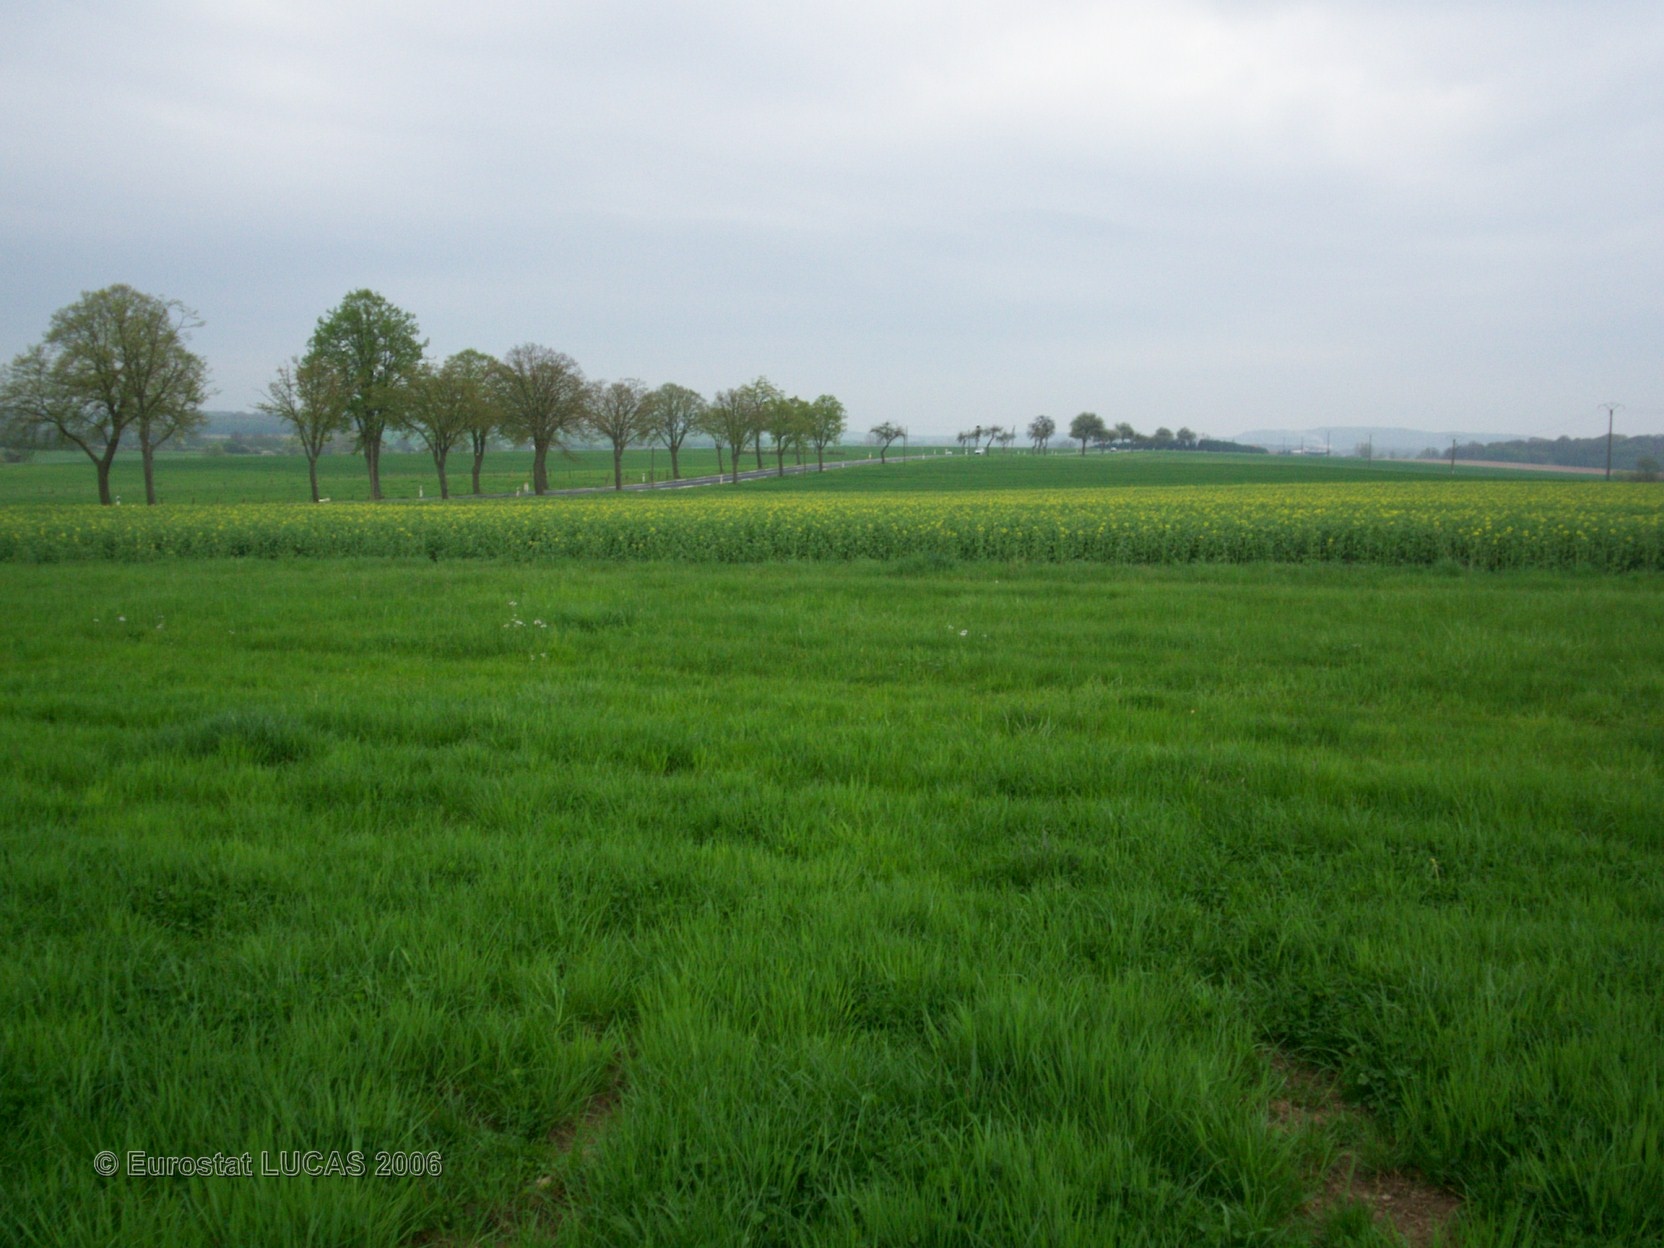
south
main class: Grassland
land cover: Grassland without tree/shrub cover
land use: Agriculture (excluding fallow land and kitchen gardens)
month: April
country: FR
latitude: 48.9511
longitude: 6.7913
